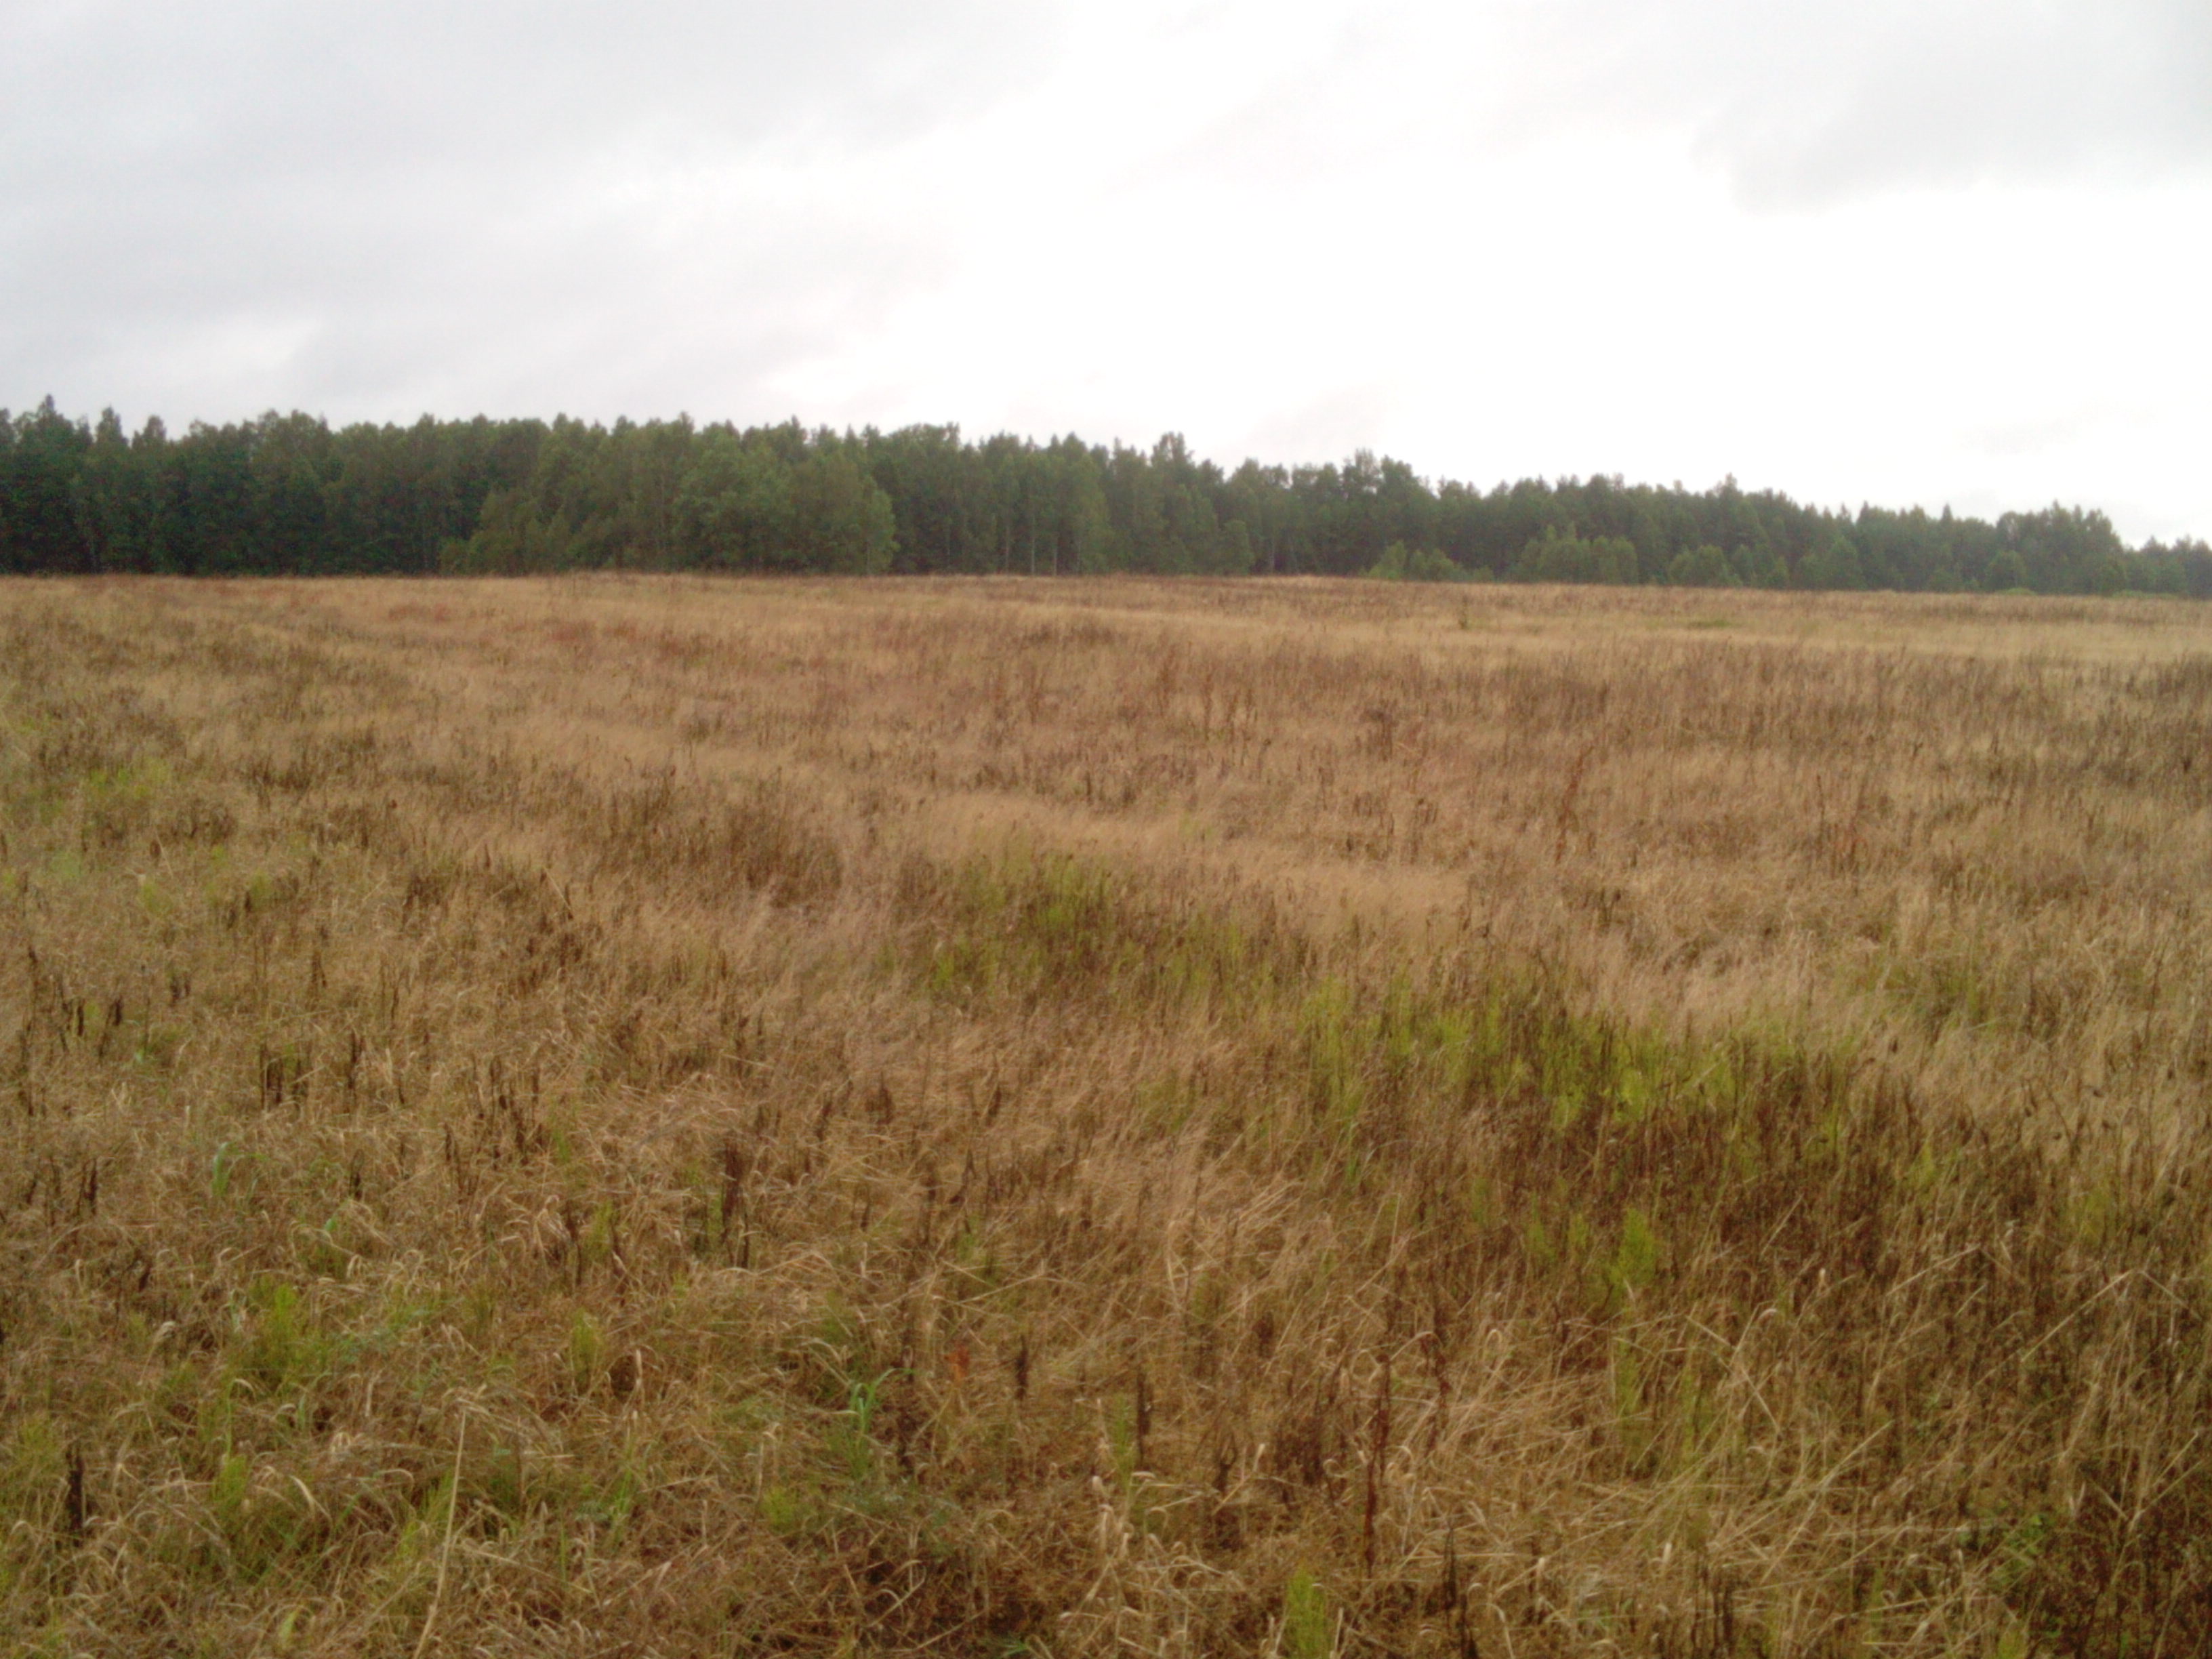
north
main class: Grassland
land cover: Grassland without tree/shrub cover
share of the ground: > 75 %
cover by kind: herbaceous plants 95 %, unconsolidated bare surface 5 %
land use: Agriculture (excluding fallow land and kitchen gardens)
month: July
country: LV
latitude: 57.0481
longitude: 22.1318
